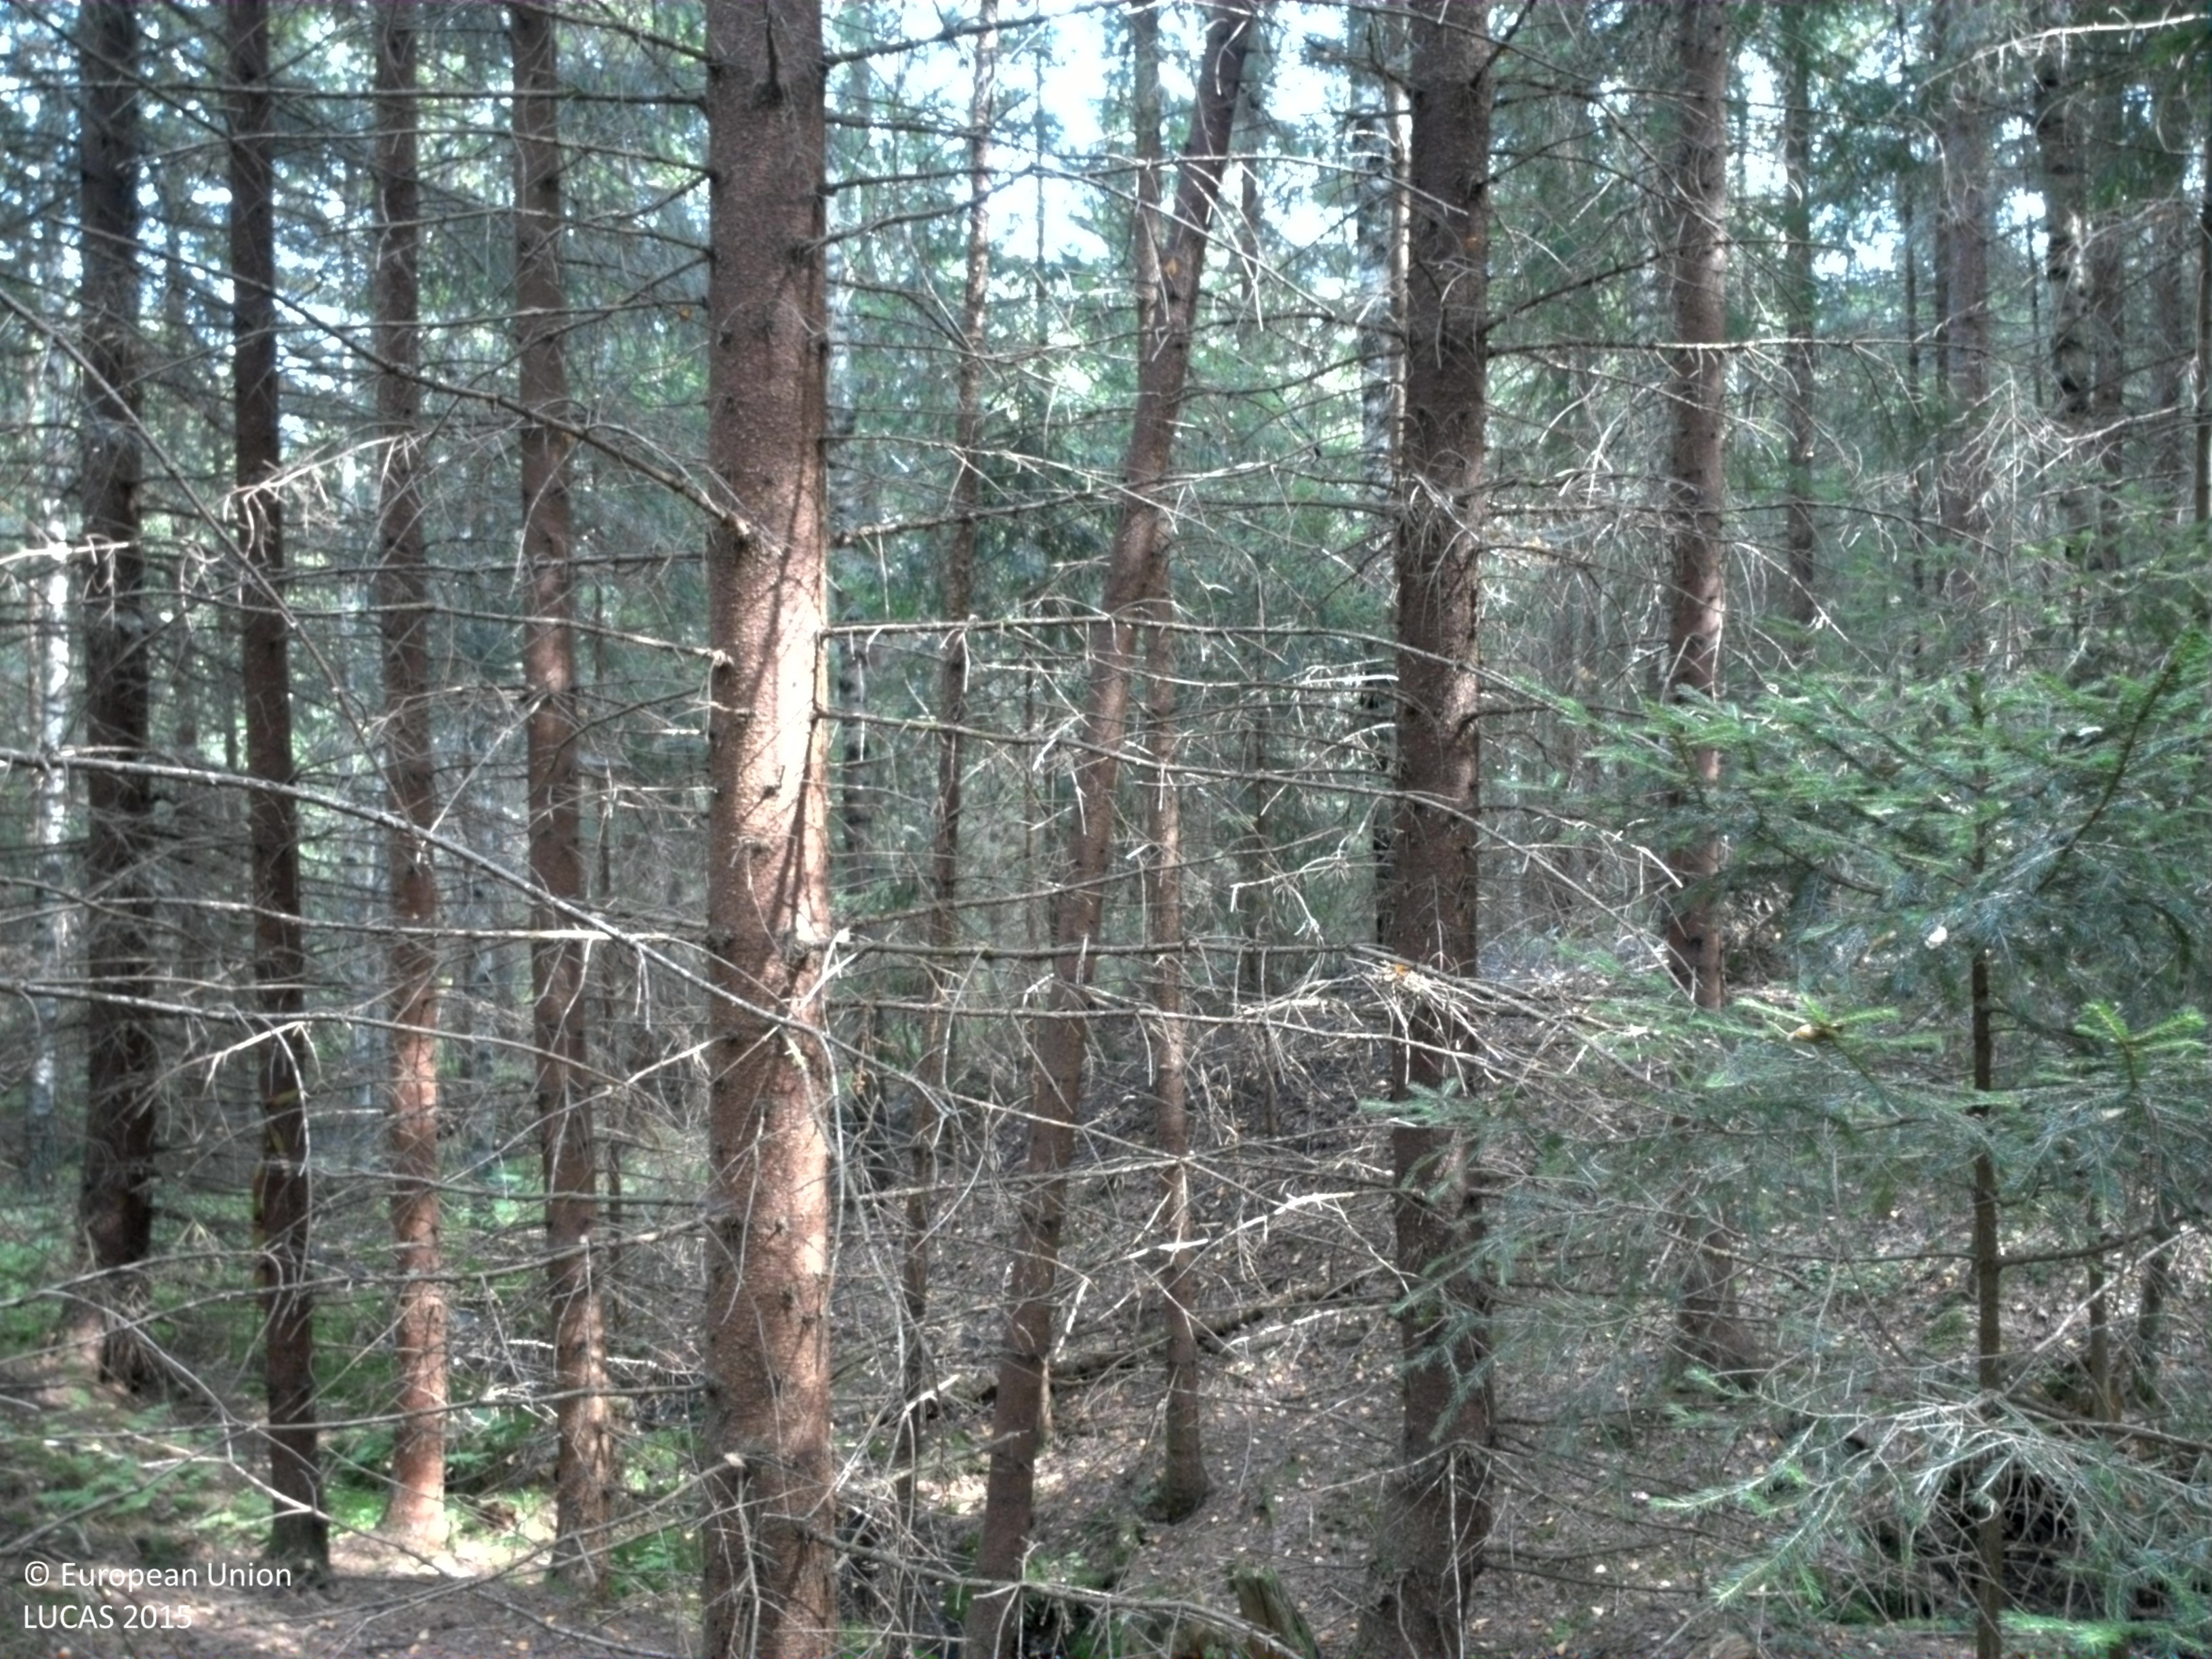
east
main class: Woodland
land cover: Spruce dominated coniferous woodland
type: boreal forest
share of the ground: 50 - 75 %
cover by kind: coniferous forest trees 65 %, lichens and mosses 20 %, broadleaved forest trees 5 %, shrubs 5 %, herbaceous plants 5 %
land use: Forestry
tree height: > 5 m
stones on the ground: < 10 %
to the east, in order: Spruce dominated coniferous woodland; Rivers and streams; Spruce dominated coniferous woodland; Pine dominated coniferous woodland; Tracks; Pine dominated mixed woodland; Pine dominated coniferous woodland
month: August
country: SE
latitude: 59.5998
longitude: 13.3757
